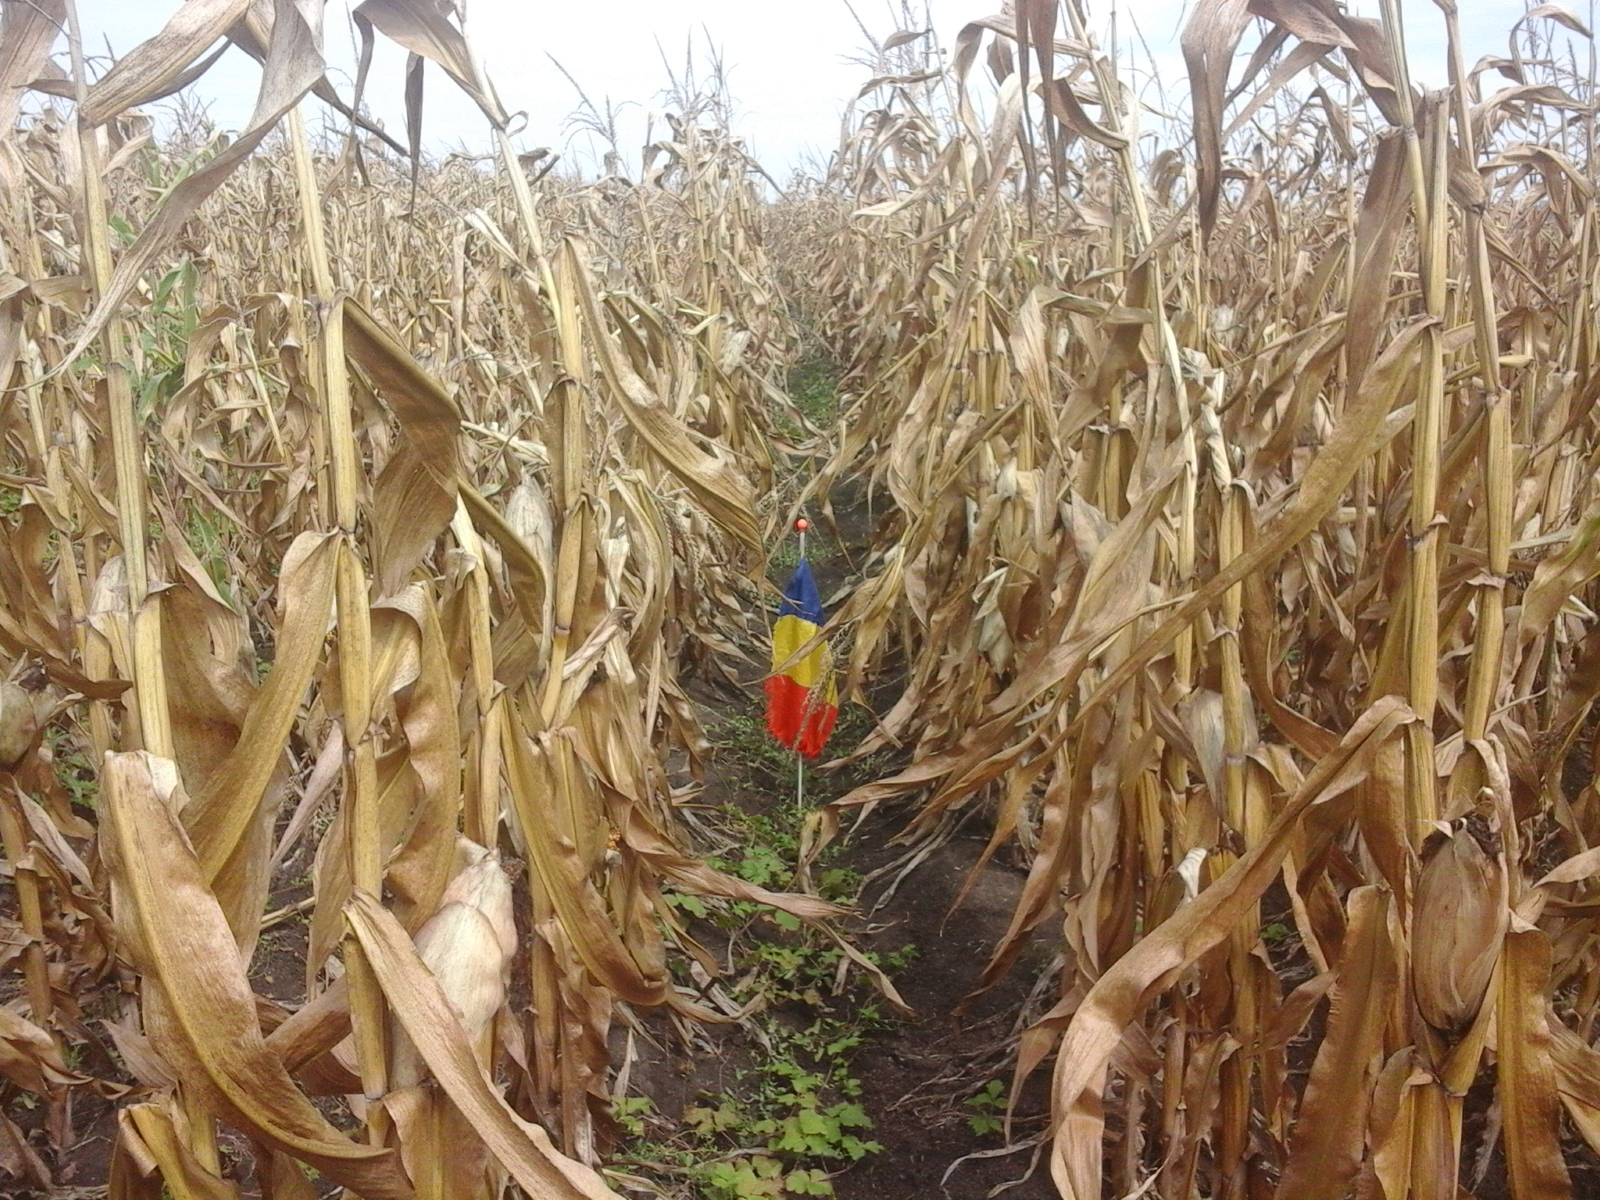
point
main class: Cropland
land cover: Maize
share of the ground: > 75 %
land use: Agriculture (excluding fallow land and kitchen gardens)
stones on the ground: < 10 %
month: August
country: RO
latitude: 46.3113
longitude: 21.6608
